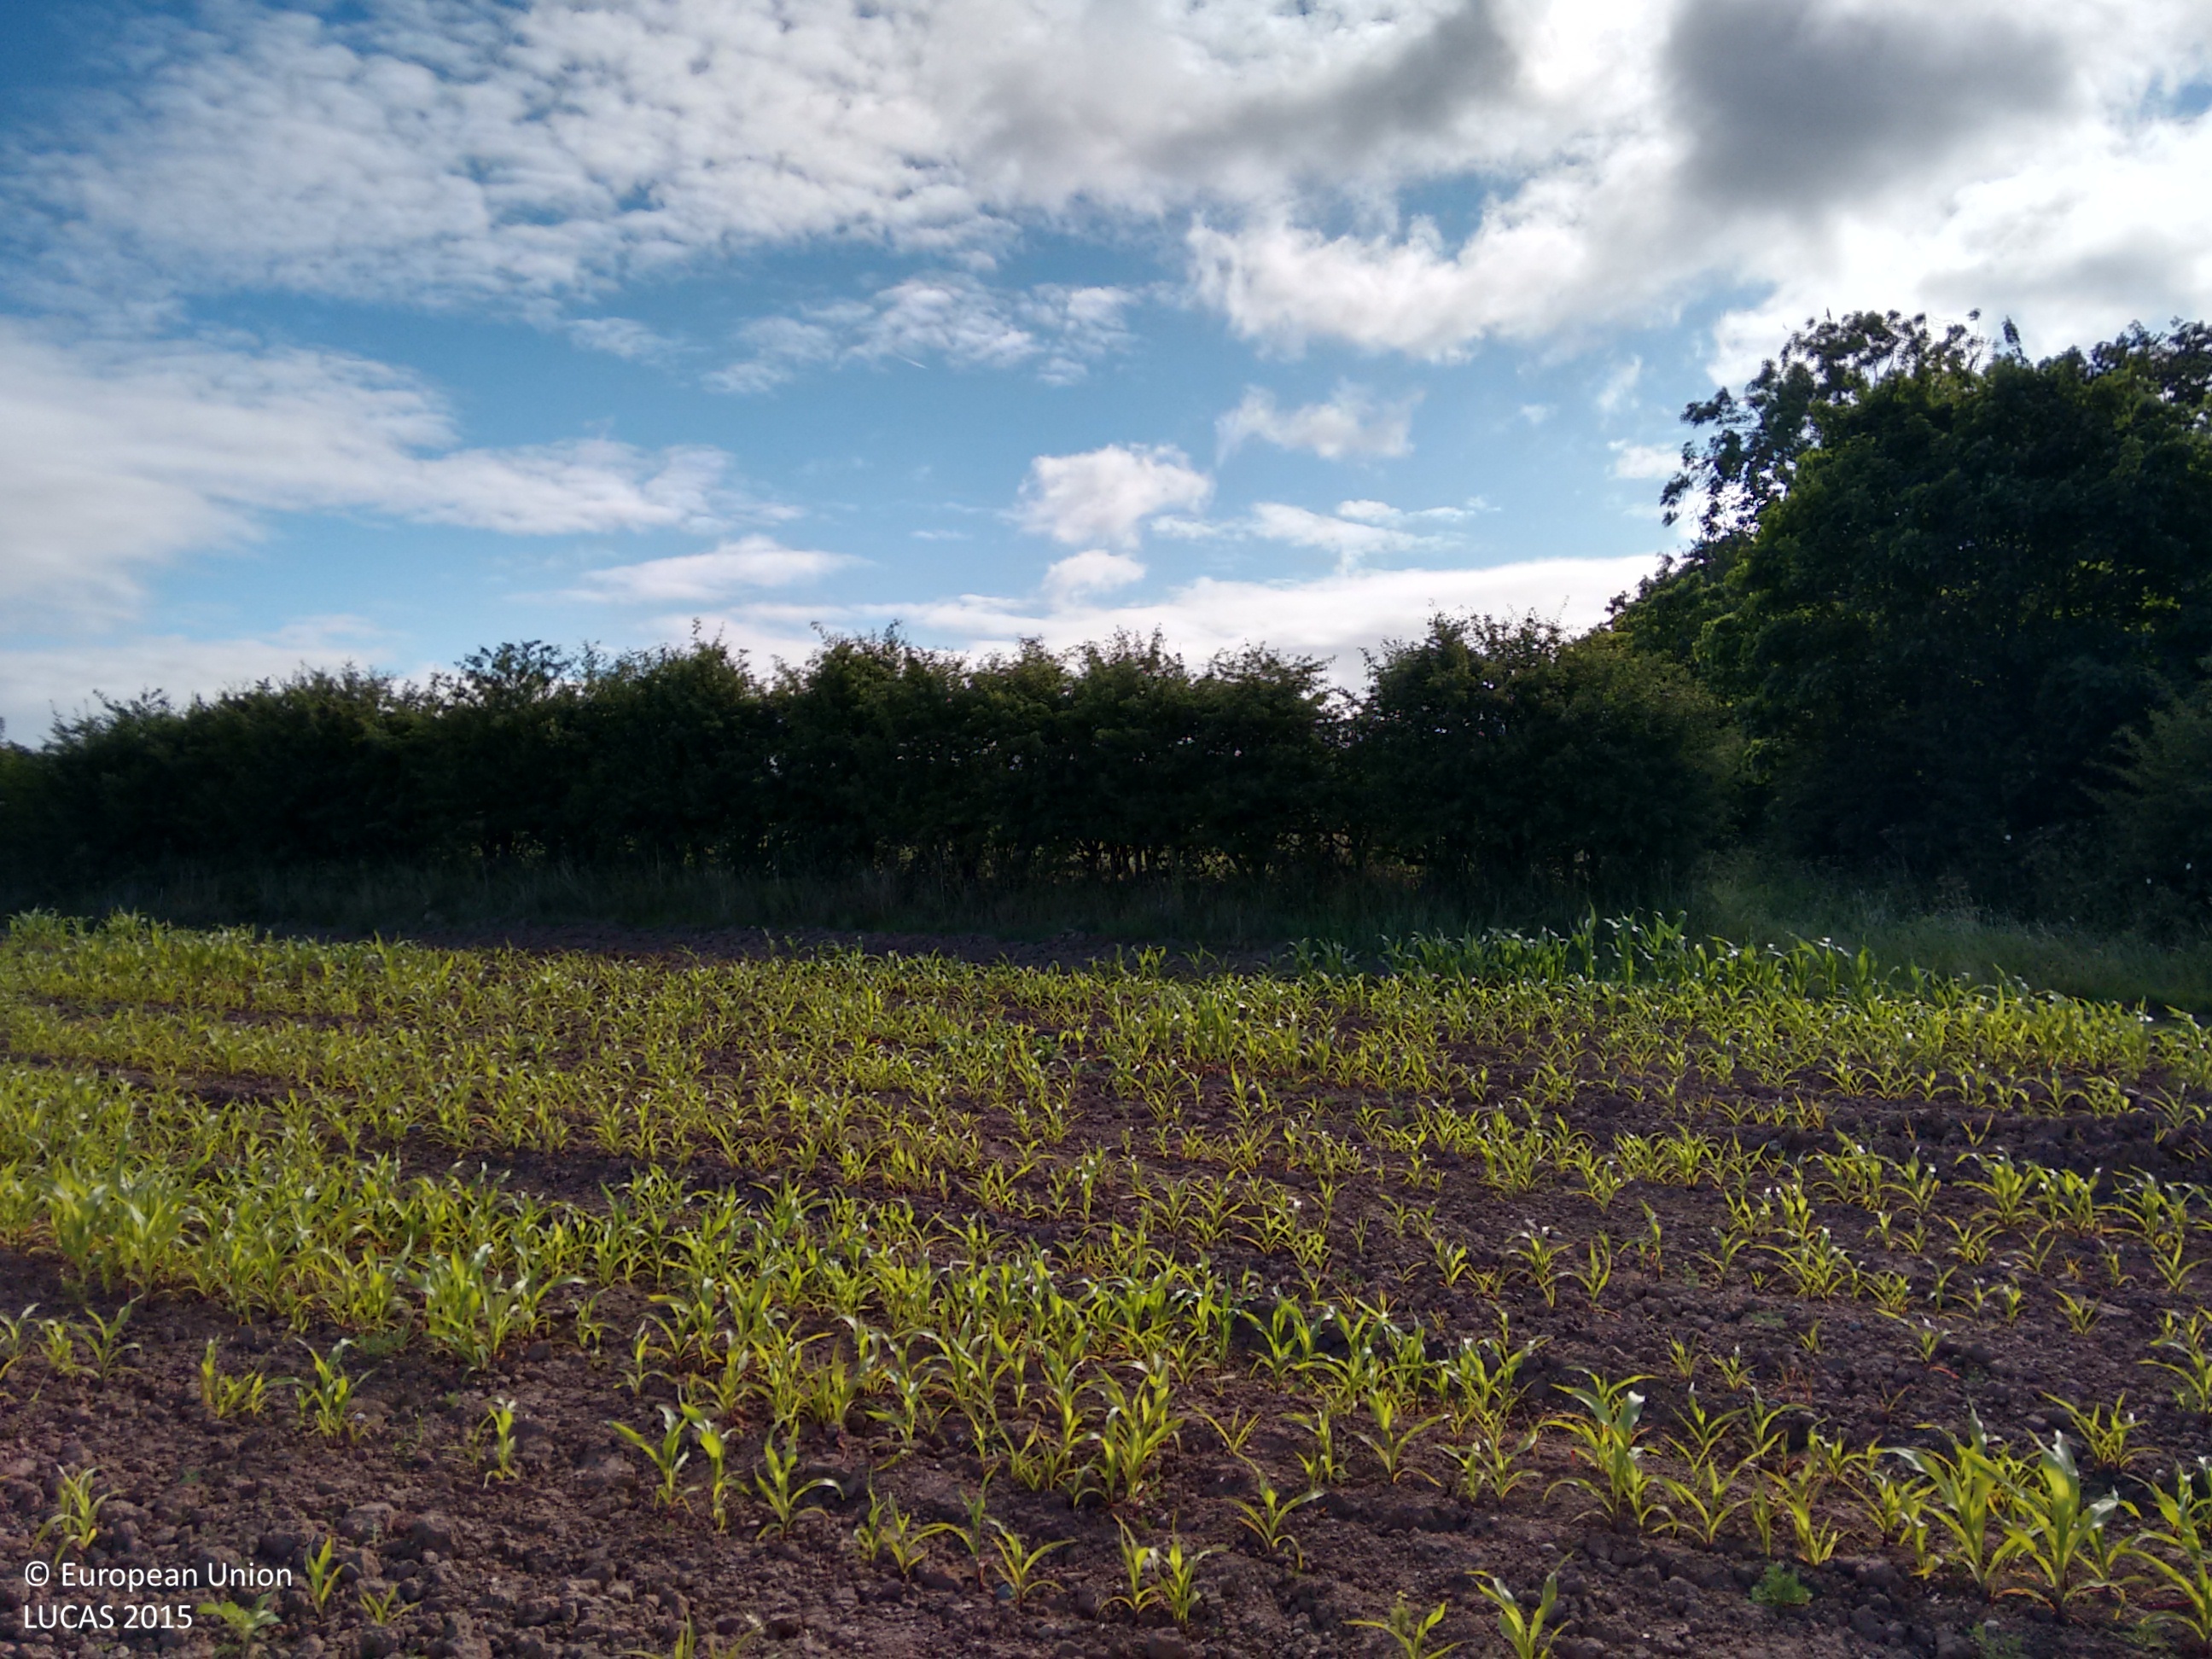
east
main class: Cropland
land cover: Common wheat
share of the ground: > 75 %
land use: Agriculture (excluding fallow land and kitchen gardens)
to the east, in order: Common wheat; Maize; Fences; Managed hedges; Maize
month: July
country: GB
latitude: 53.2189
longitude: -2.7247
